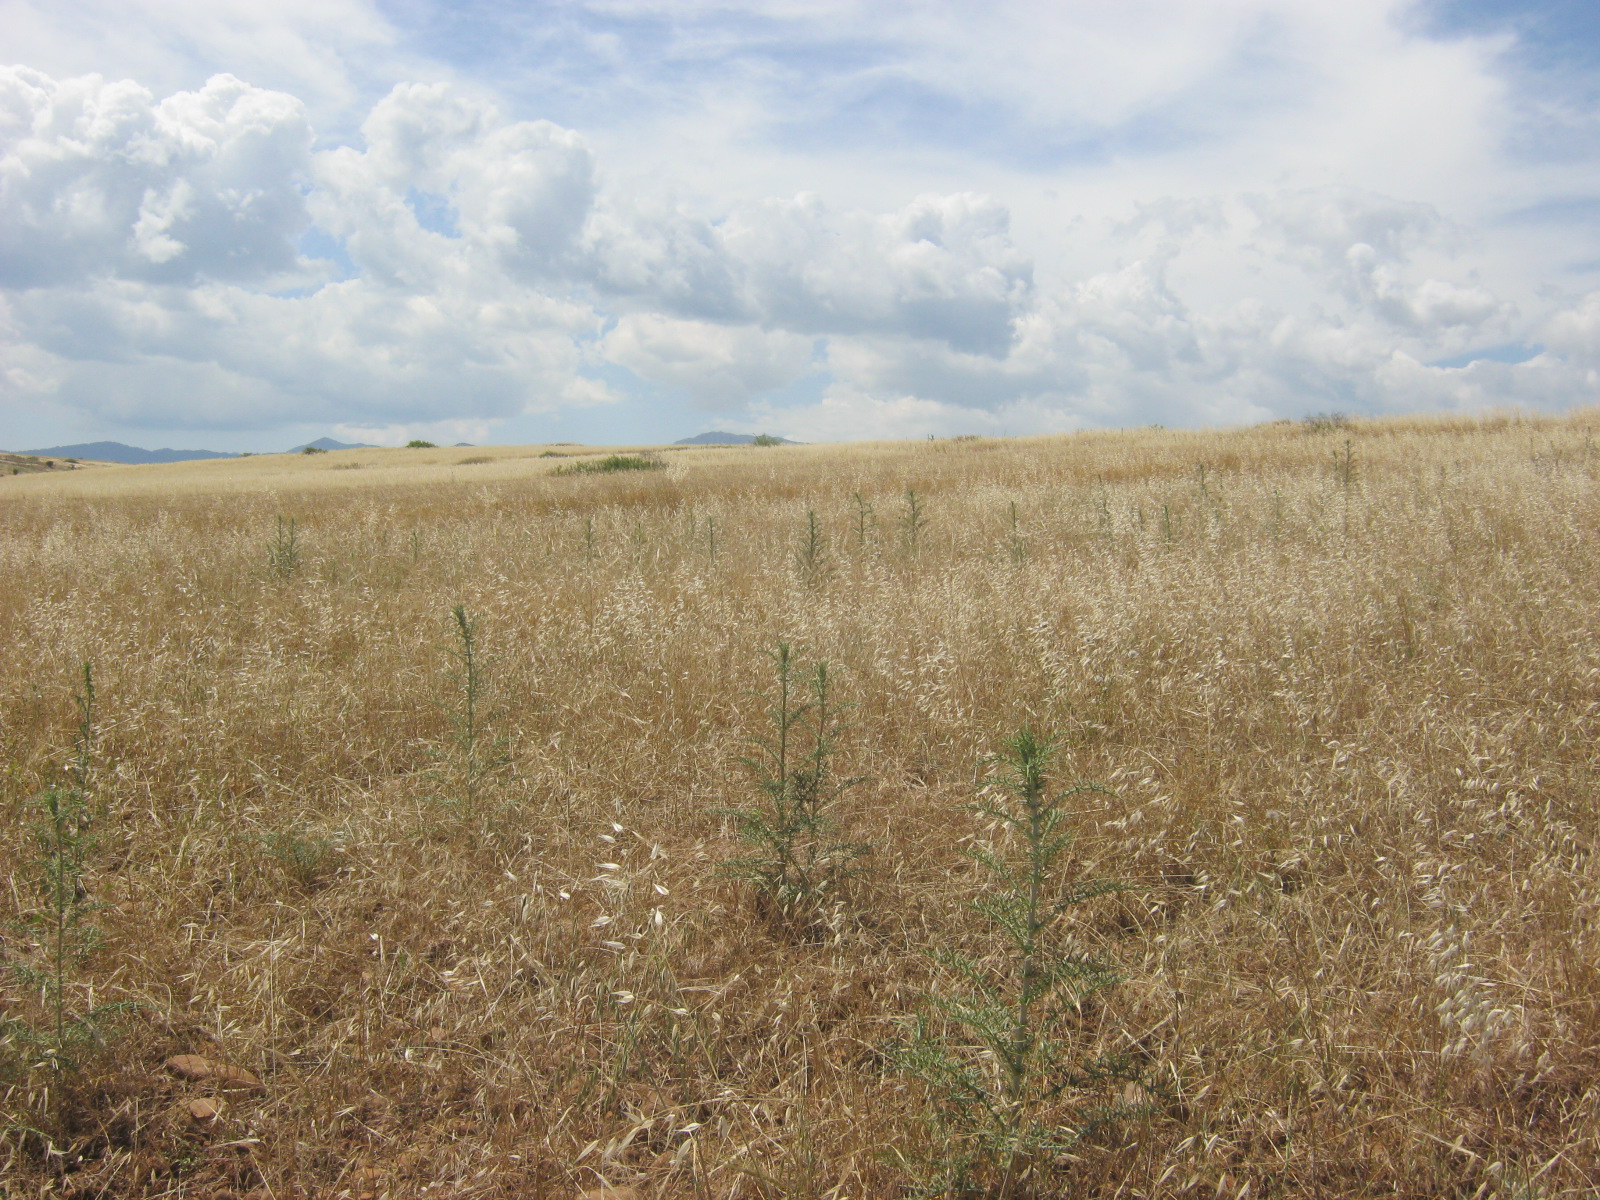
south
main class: Grassland
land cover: Spontaneously vegetated surfaces
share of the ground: > 75 %
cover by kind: herbaceous plants 100 %
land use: Semi-natural and natural areas not in use
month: May
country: CY
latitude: 35.1103
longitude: 33.0096
